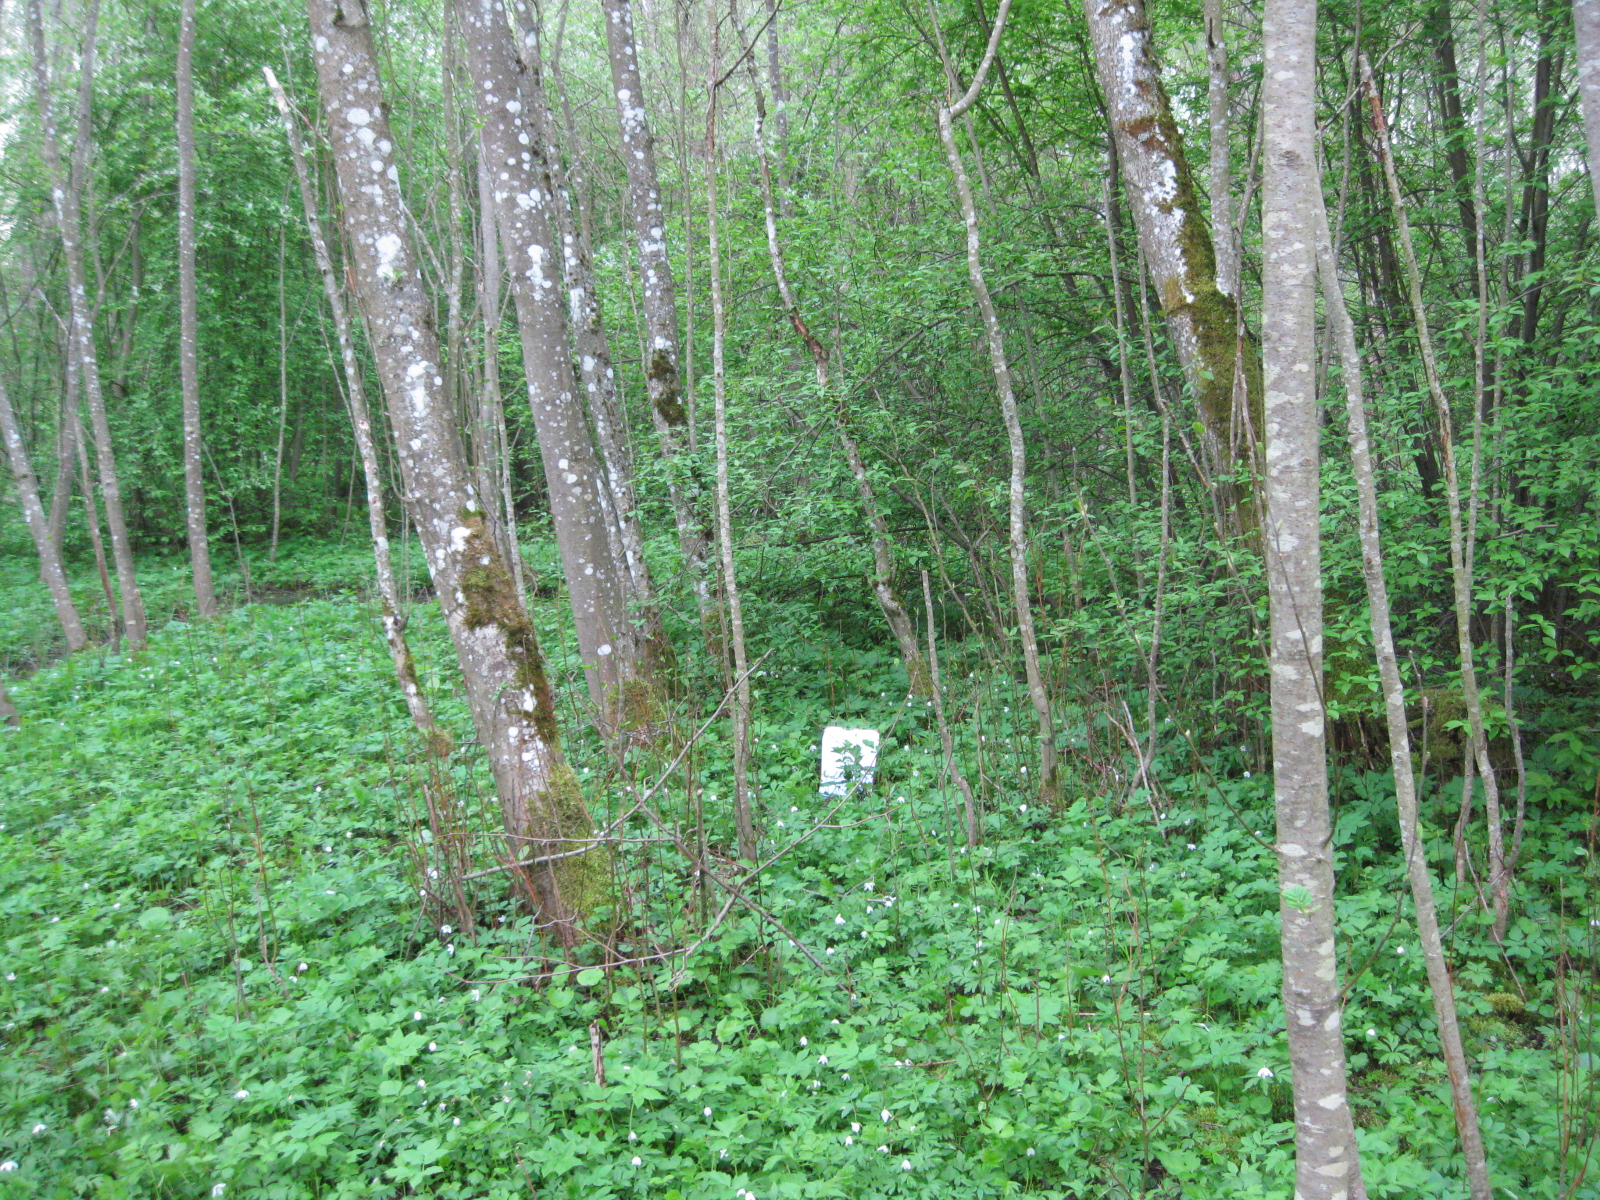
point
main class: Woodland
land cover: Broadleaved woodland
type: non-riverine alder, birch or aspen forest
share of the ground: > 75 %
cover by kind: broadleaved forest trees 85 %, herbaceous plants 10 %, lichens and mosses 5 %
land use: Forestry
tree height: > 5 m
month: May
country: LT
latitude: 56.2221
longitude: 24.4660
